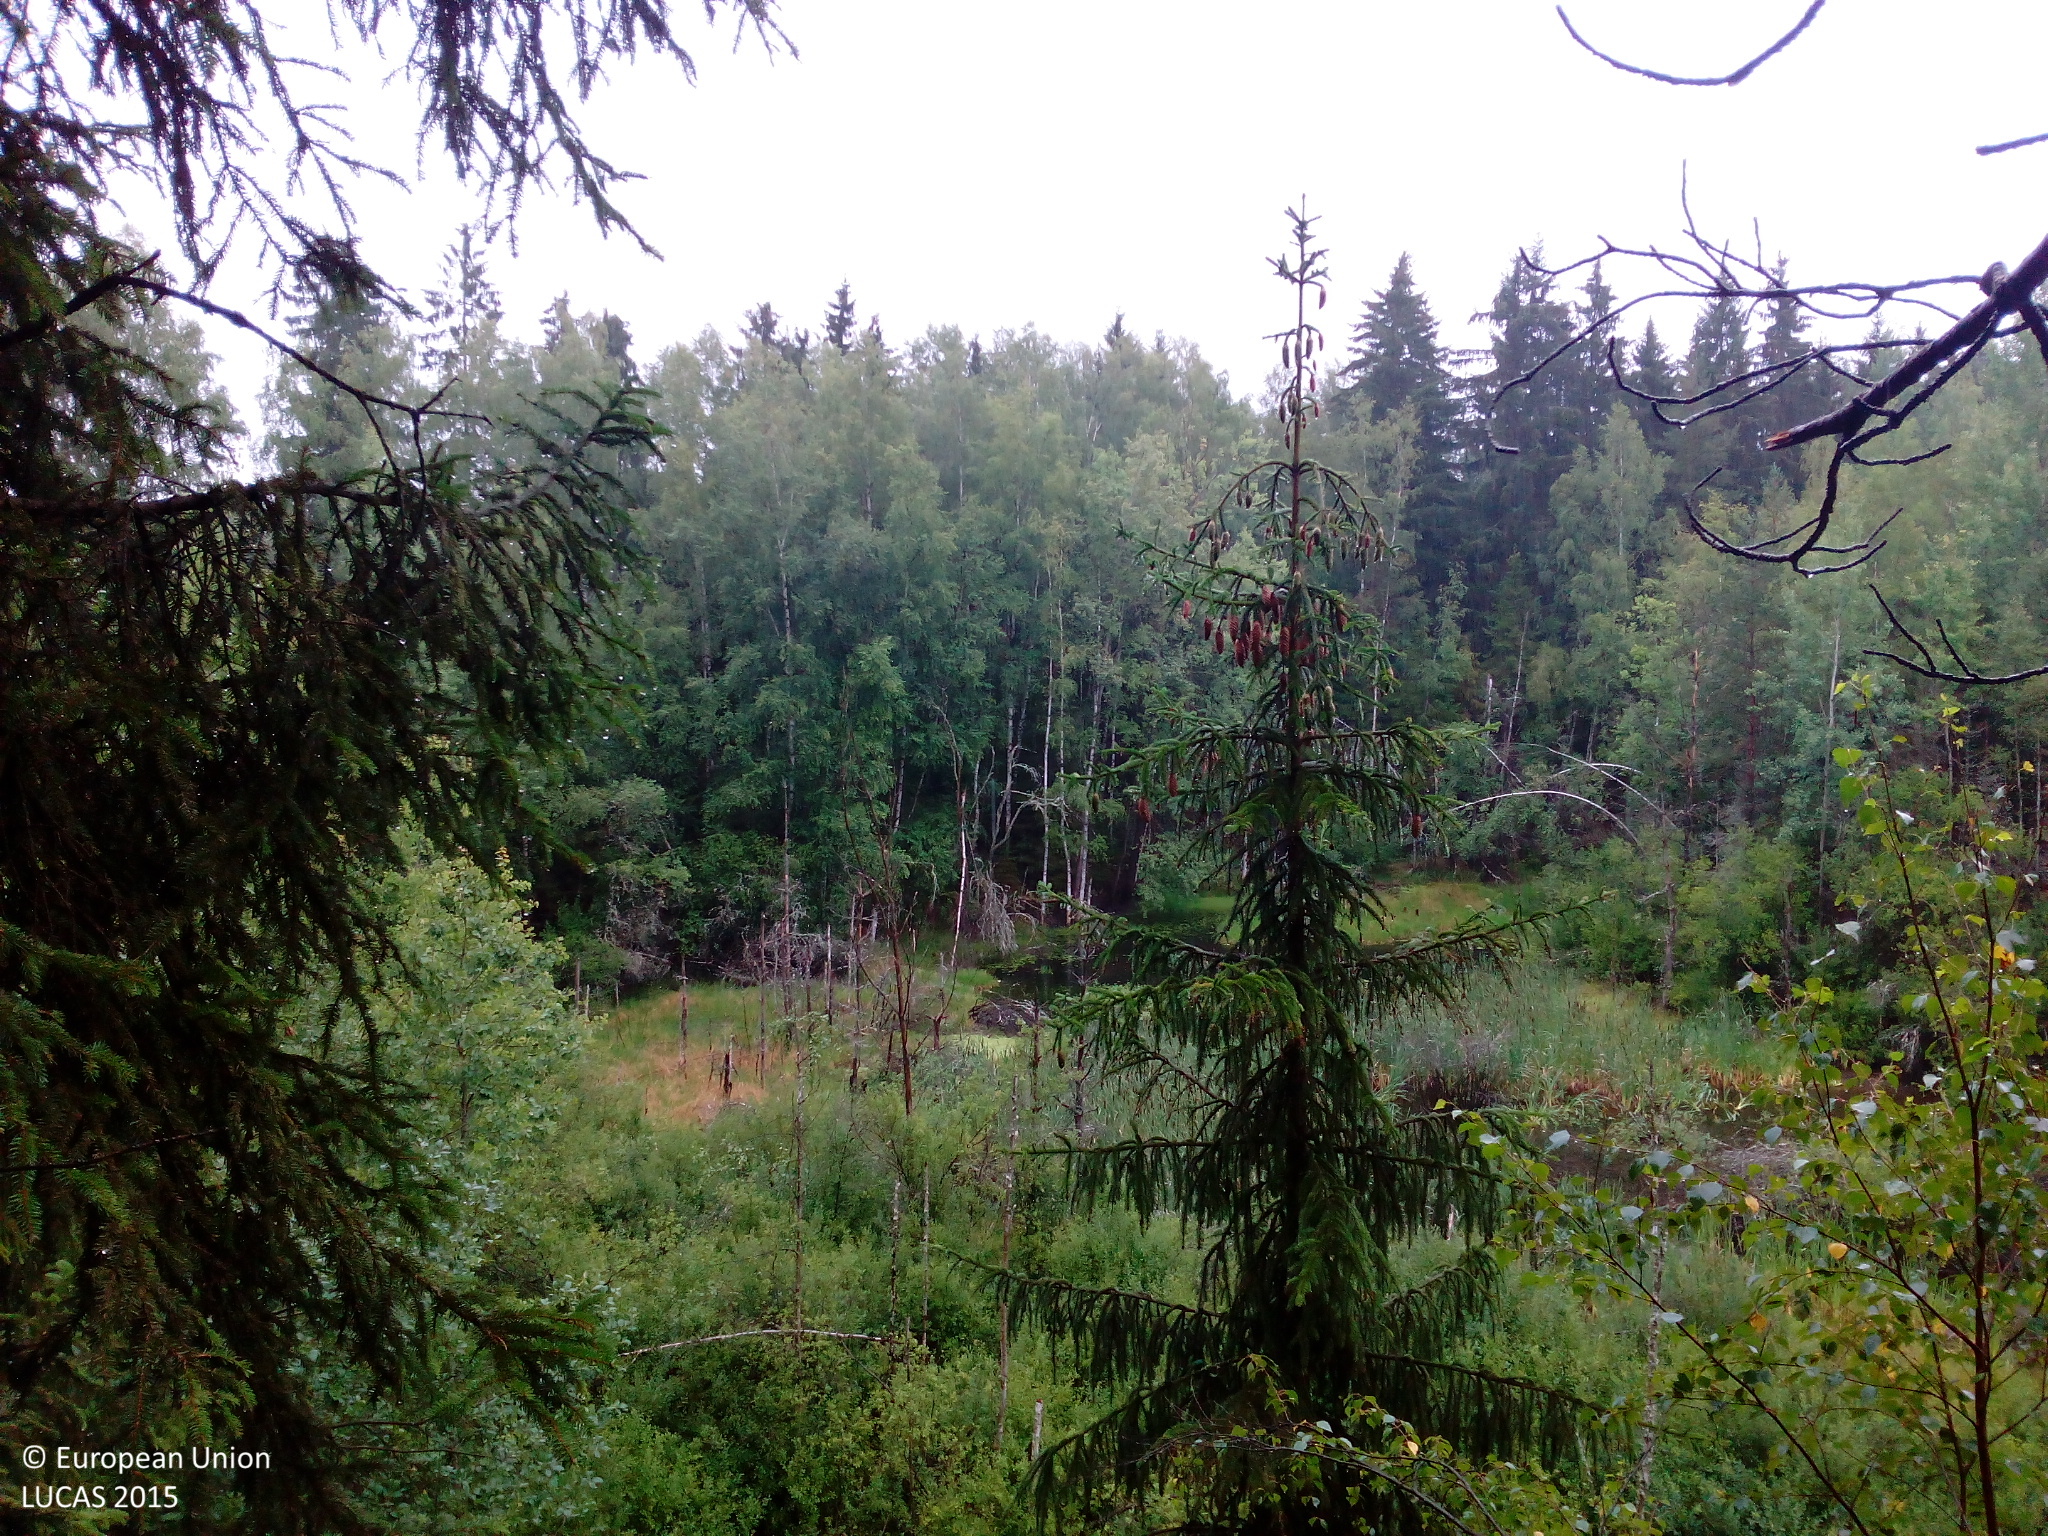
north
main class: Shrubland
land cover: Shrubland with sparse tree cover
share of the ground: > 75 %
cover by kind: shrubs 95 %, broadleaved forest trees 5 %
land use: Semi-natural and natural areas not in use
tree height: < 5 m
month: August
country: DE
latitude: 50.2191
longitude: 12.0879
